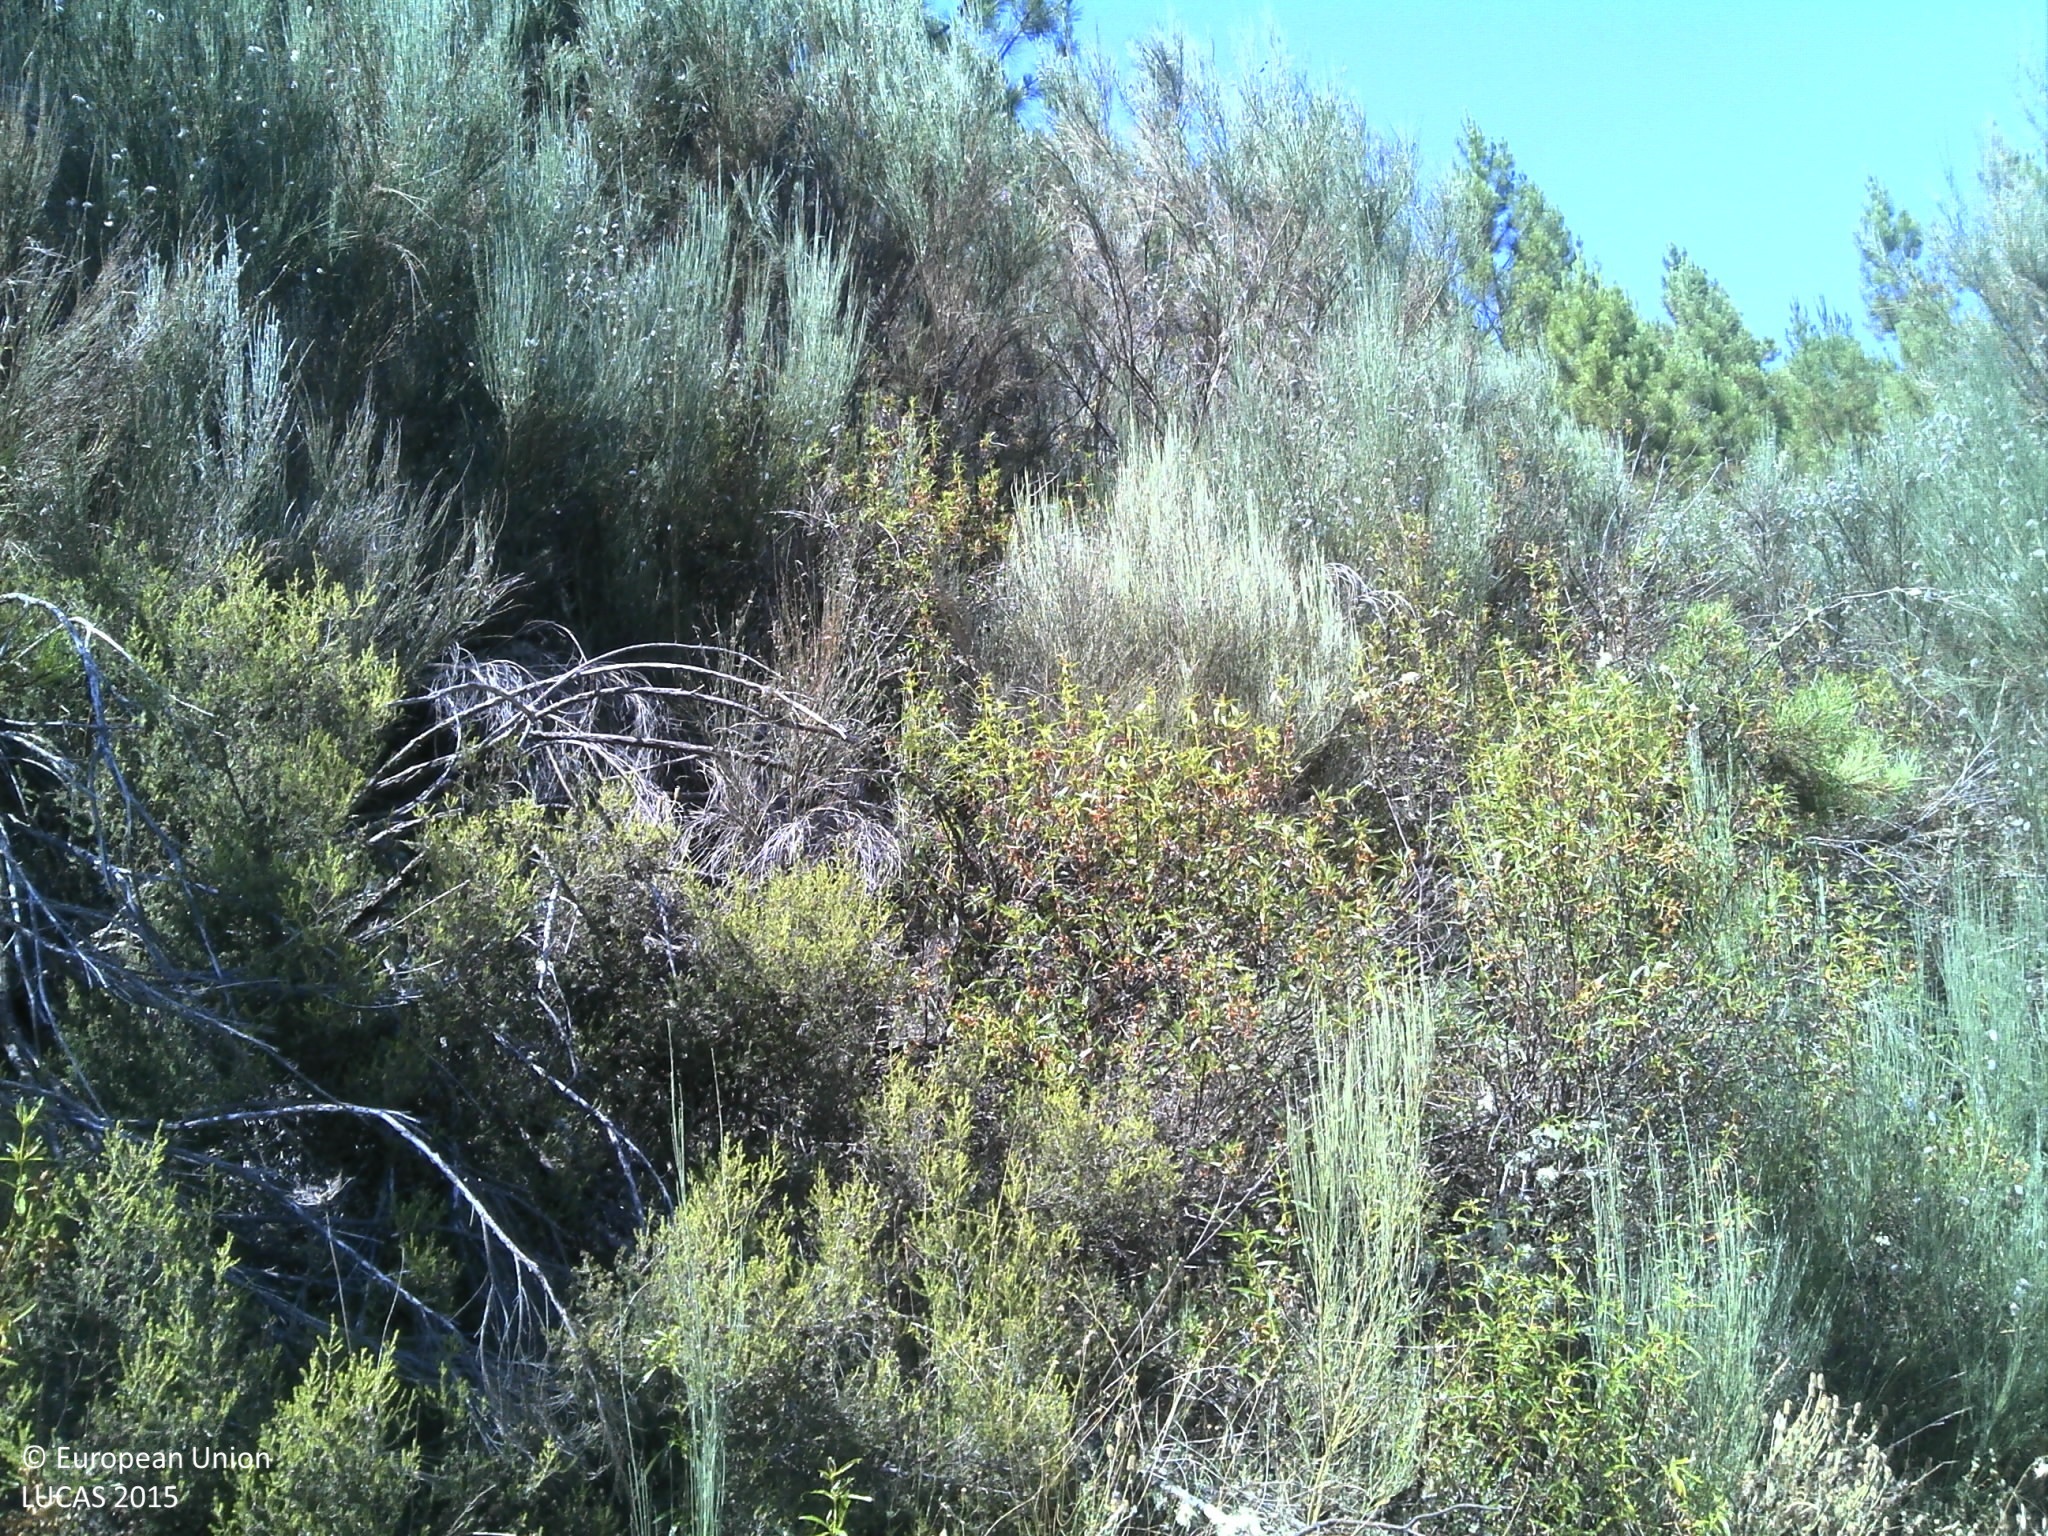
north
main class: Shrubland
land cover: Shrubland with sparse tree cover
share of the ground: 50 - 75 %
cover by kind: shrubs 75 %, unconsolidated bare surface 10 %, coniferous forest trees 5 %, herbaceous plants 5 %
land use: Semi-natural and natural areas not in use
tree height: > 5 m
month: July
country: PT
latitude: 40.3900
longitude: -7.4367
